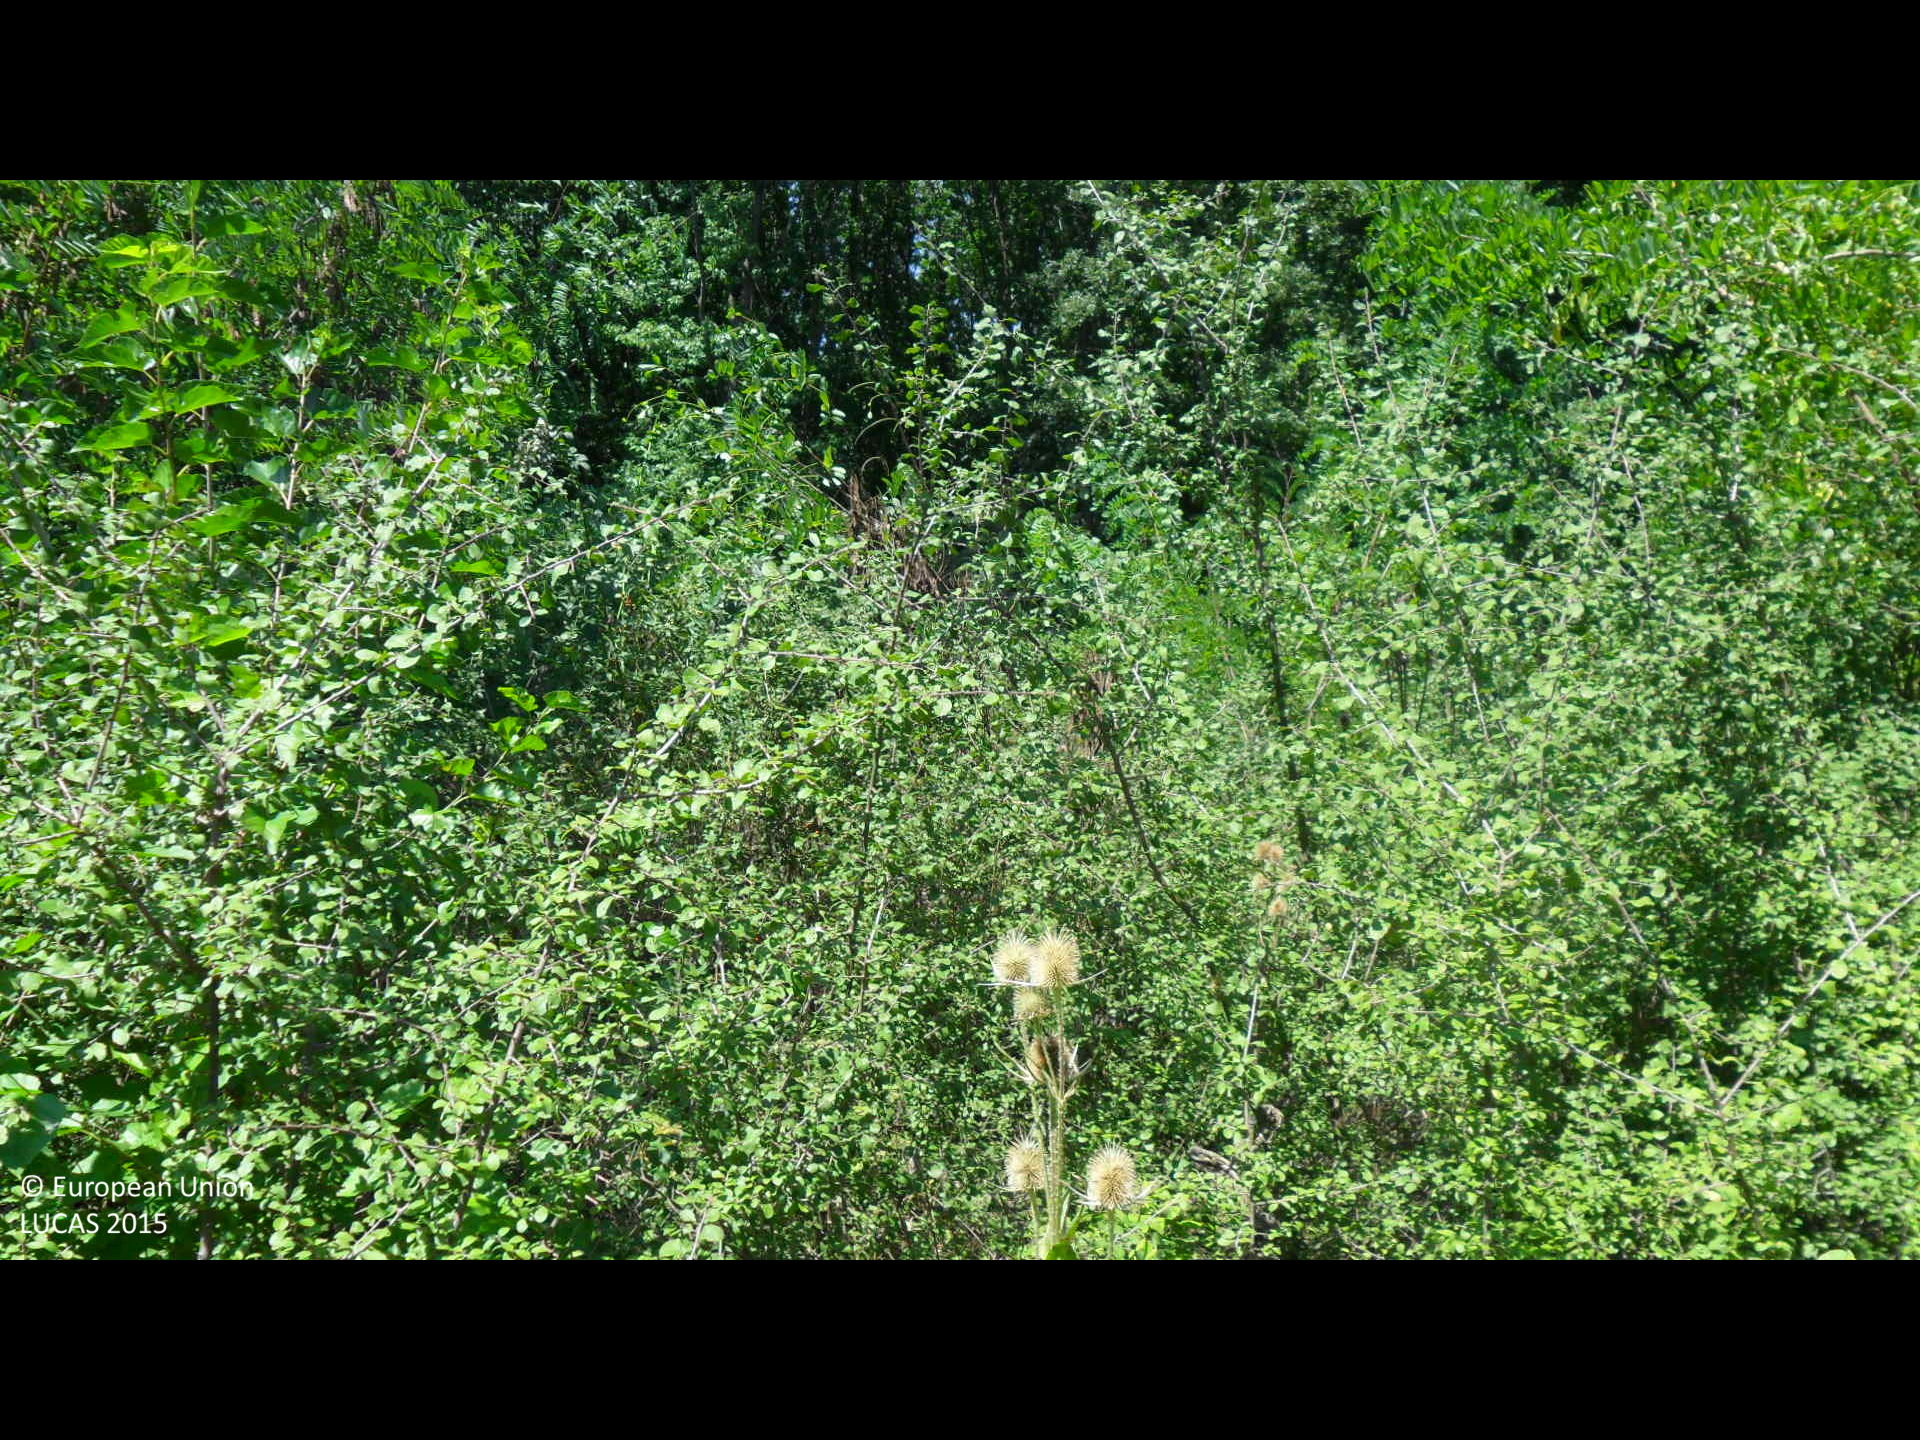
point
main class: Woodland
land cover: Broadleaved woodland
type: mesophytic deciduous forest
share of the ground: > 75 %
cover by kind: broadleaved forest trees 100 %
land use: Forestry
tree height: > 5 m
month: August
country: BG
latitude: 43.2223
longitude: 26.7144
